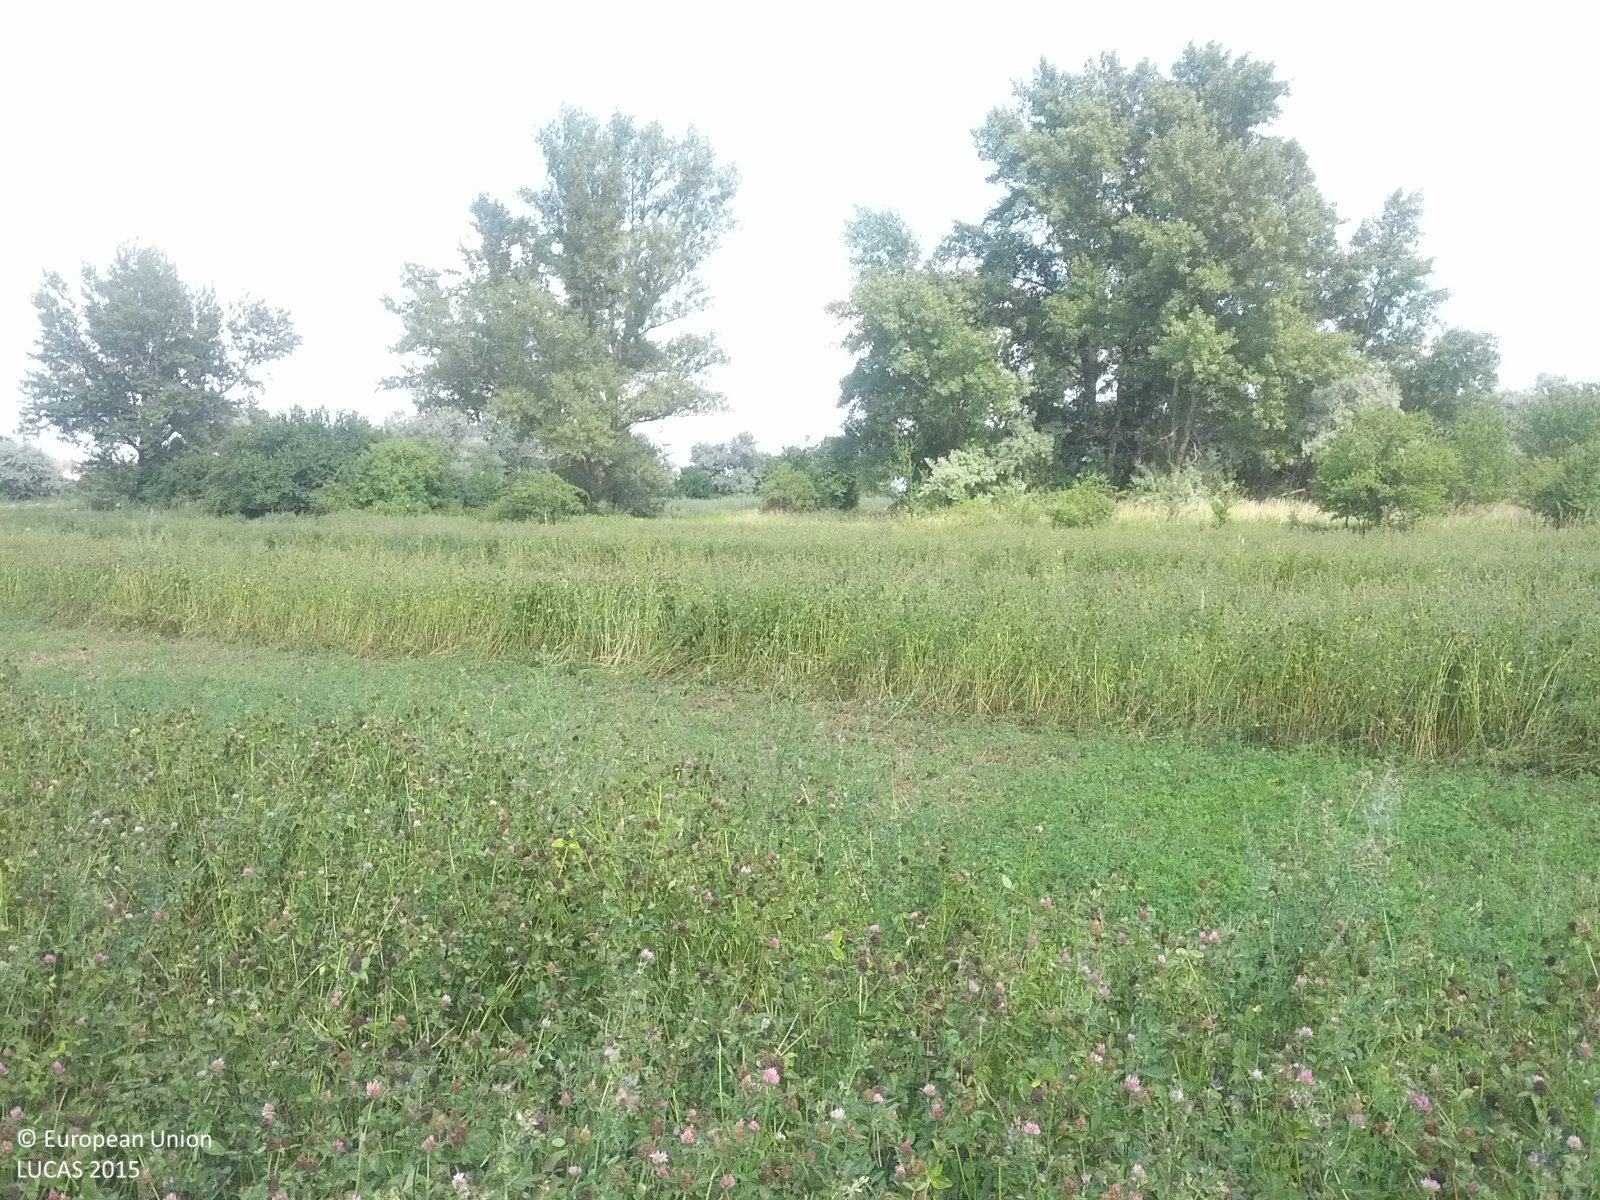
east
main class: Cropland
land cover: Clovers
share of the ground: > 75 %
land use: Agriculture (excluding fallow land and kitchen gardens)
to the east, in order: Clovers; Shrubland without tree cover; Broadleaved woodland; Tracks; Grassland without tree/shrub cover; Tracks; Grassland without tree/shrub cover; Broadleaved woodland; Grass margins; Other cereals
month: June
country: AT
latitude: 48.3797
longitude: 16.7171
